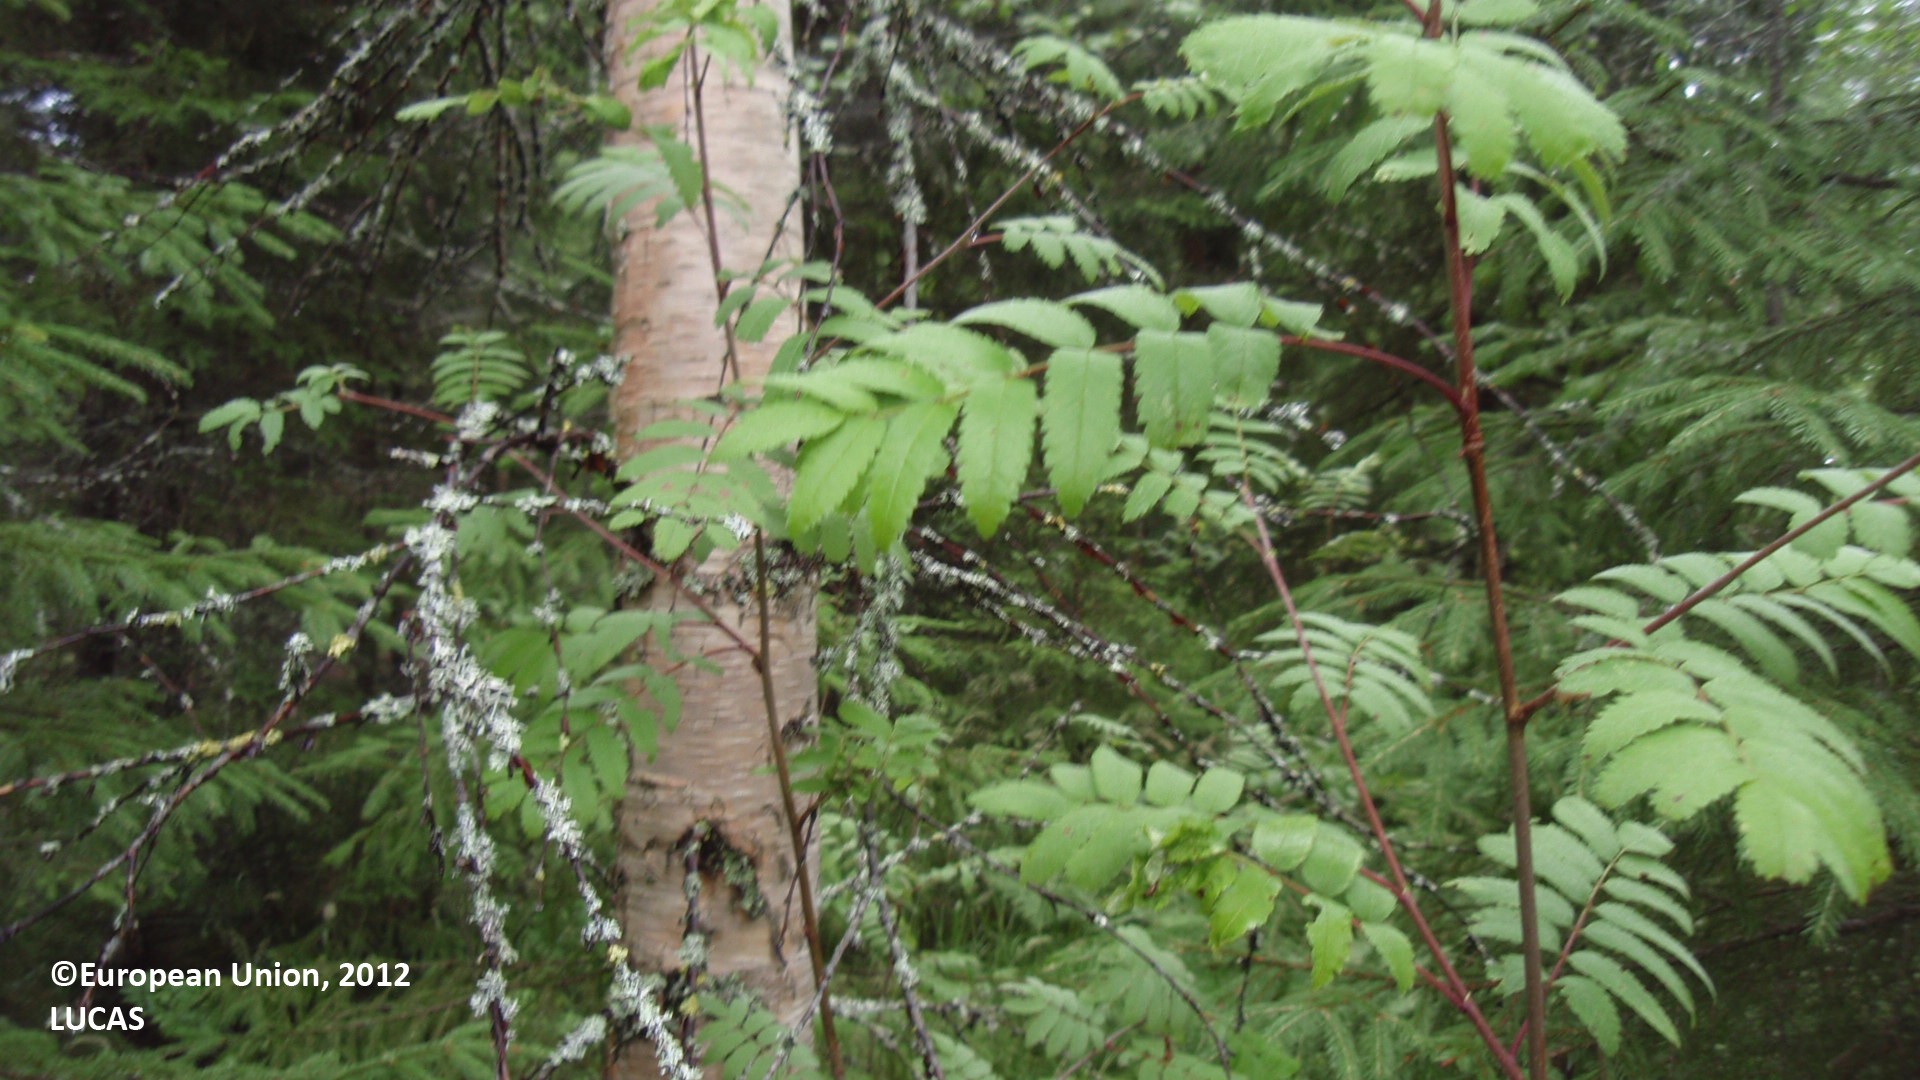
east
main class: Woodland
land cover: Spruce dominated mixed woodland
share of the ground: > 75 %
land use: Forestry
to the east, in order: Spruce dominated mixed woodland; Tracks; Spruce dominated coniferous woodland; Broadleaved woodland; Spruce dominated coniferous woodland; Shrubland with sparse tree cover; Lichens and moss; Shrubland with sparse tree cover
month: July
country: FI
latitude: 61.5852
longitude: 27.2553
